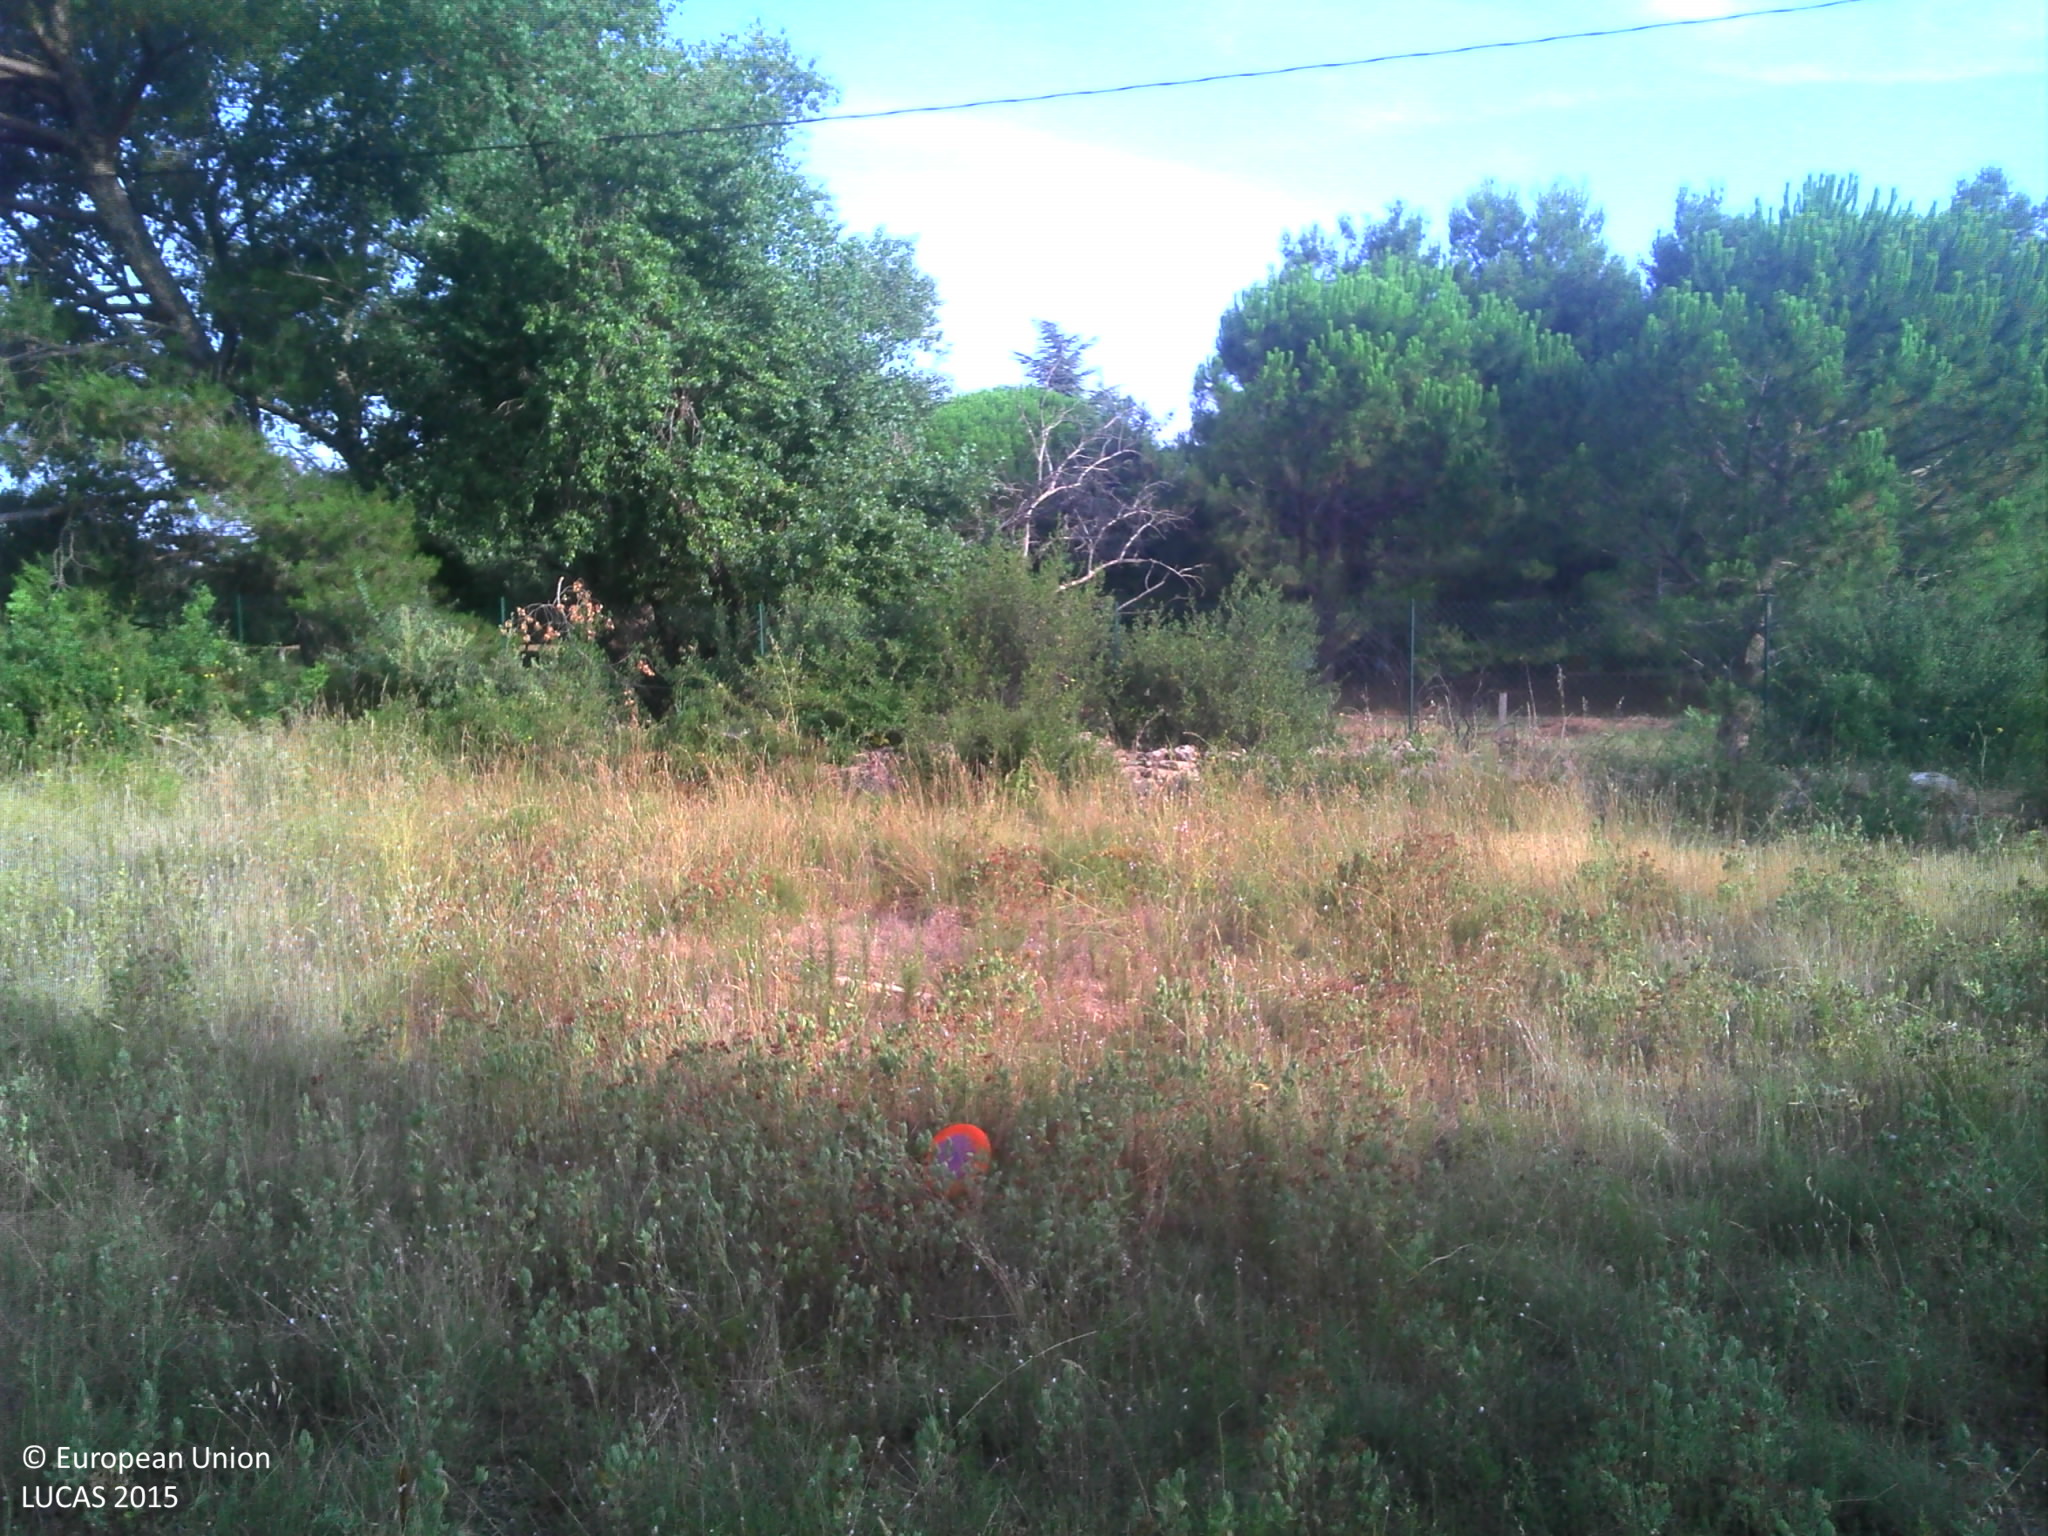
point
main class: Grassland
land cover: Grassland with sparse tree/shrub cover
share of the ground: > 75 %
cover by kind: herbaceous plants 75 %, coniferous forest trees 5 %, shrubs 5 %, consolidated bare surface 5 %
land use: Abandoned areas
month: July
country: FR
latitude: 43.6019
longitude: 5.0914
